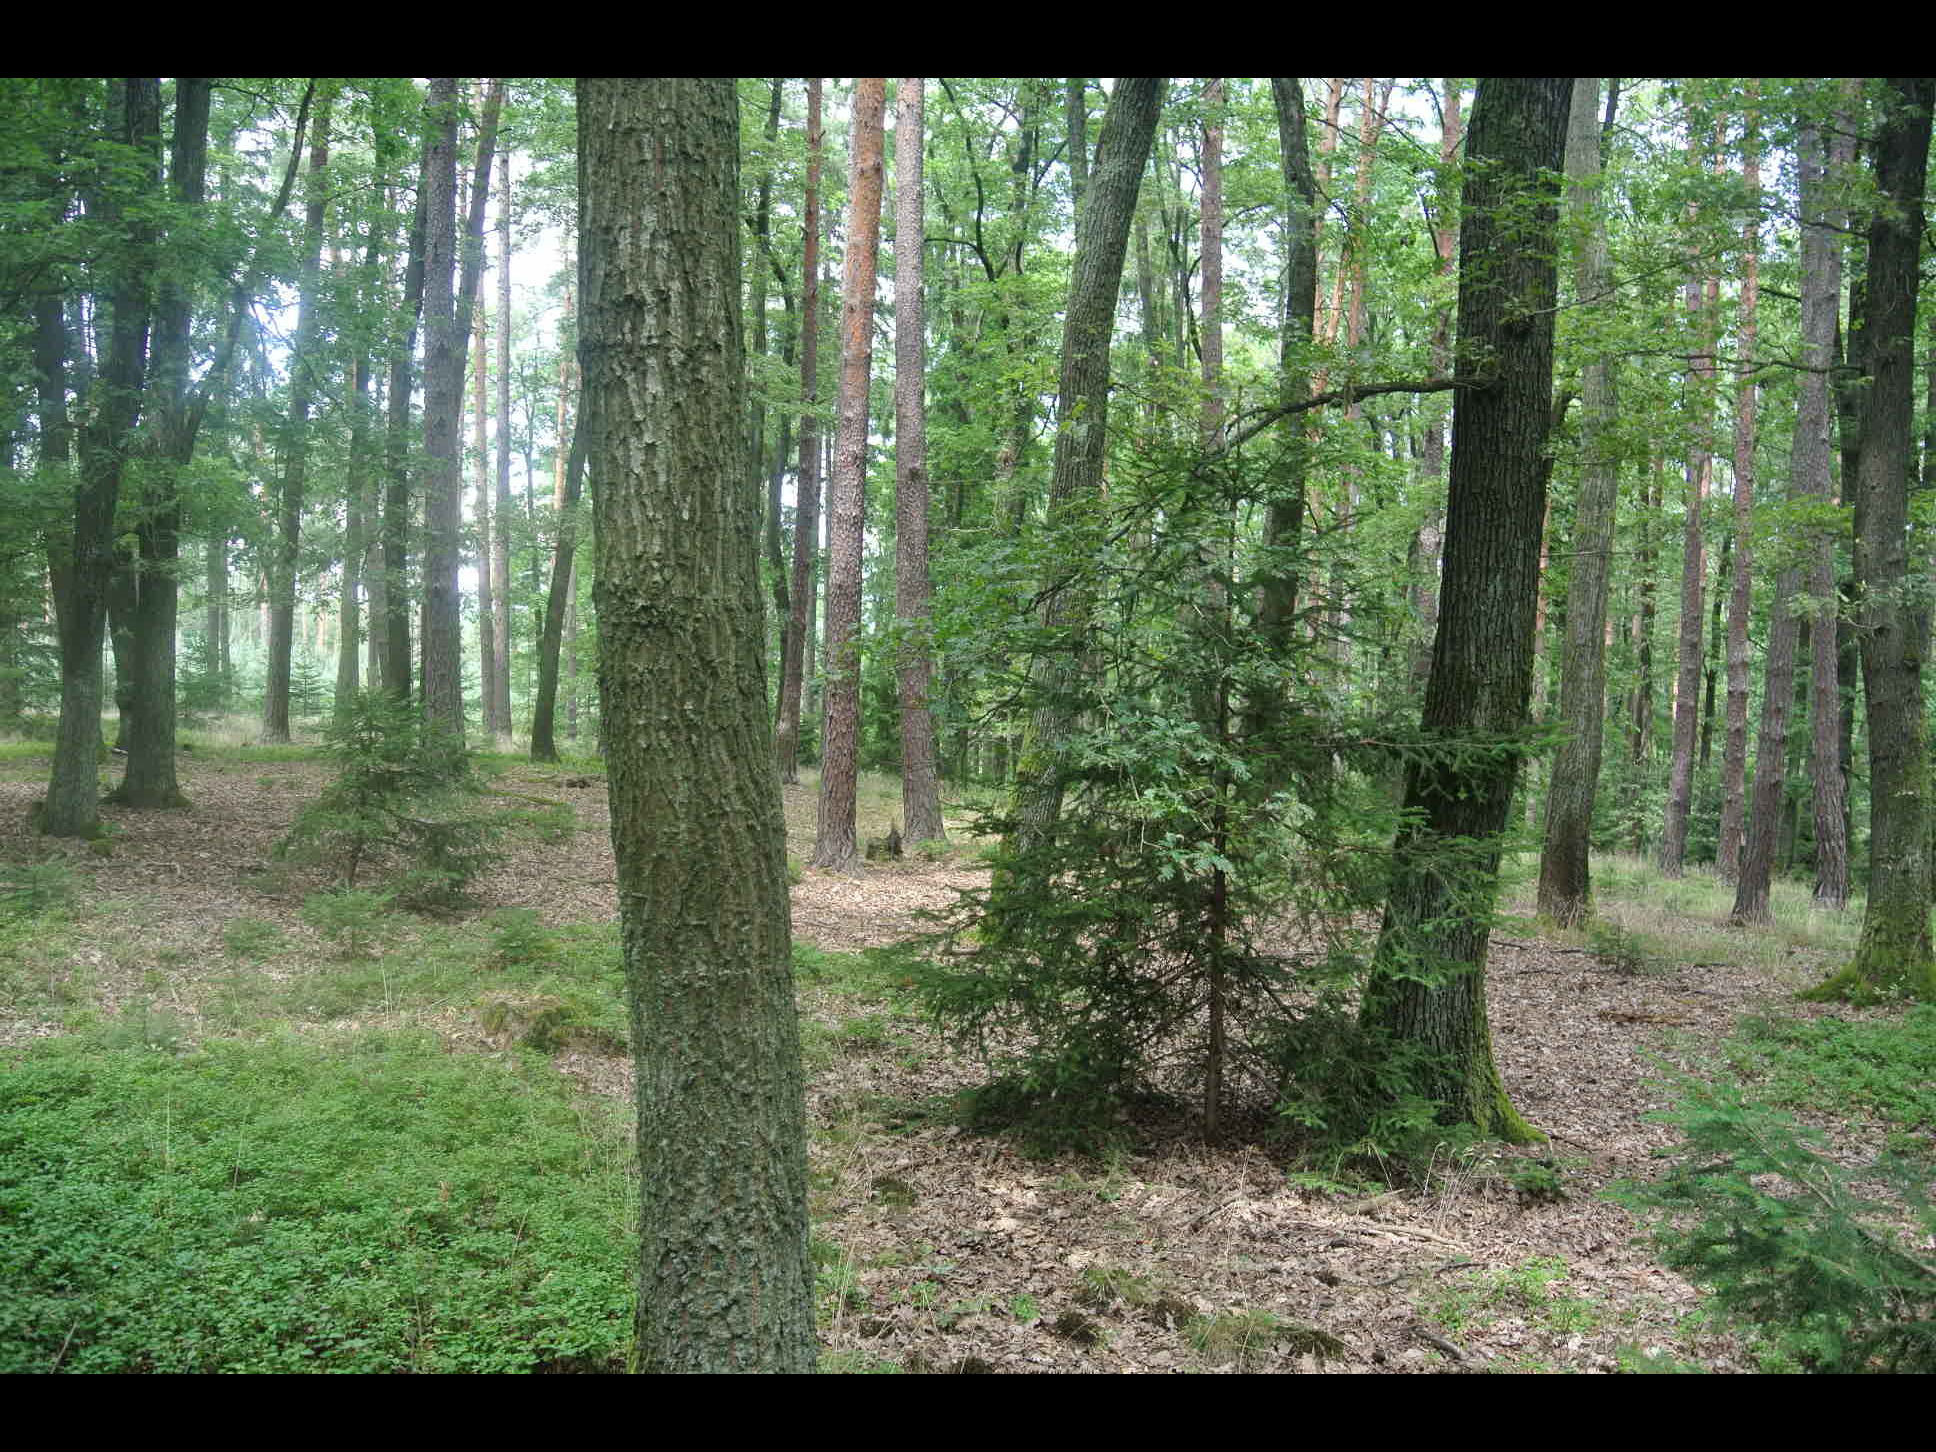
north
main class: Woodland
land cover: Pine dominated mixed woodland
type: alpine coniferous forest
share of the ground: > 75 %
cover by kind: coniferous forest trees 55 %, broadleaved forest trees 45 %
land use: Forestry
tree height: > 5 m
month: July
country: AT
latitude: 47.4756
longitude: 16.4390
